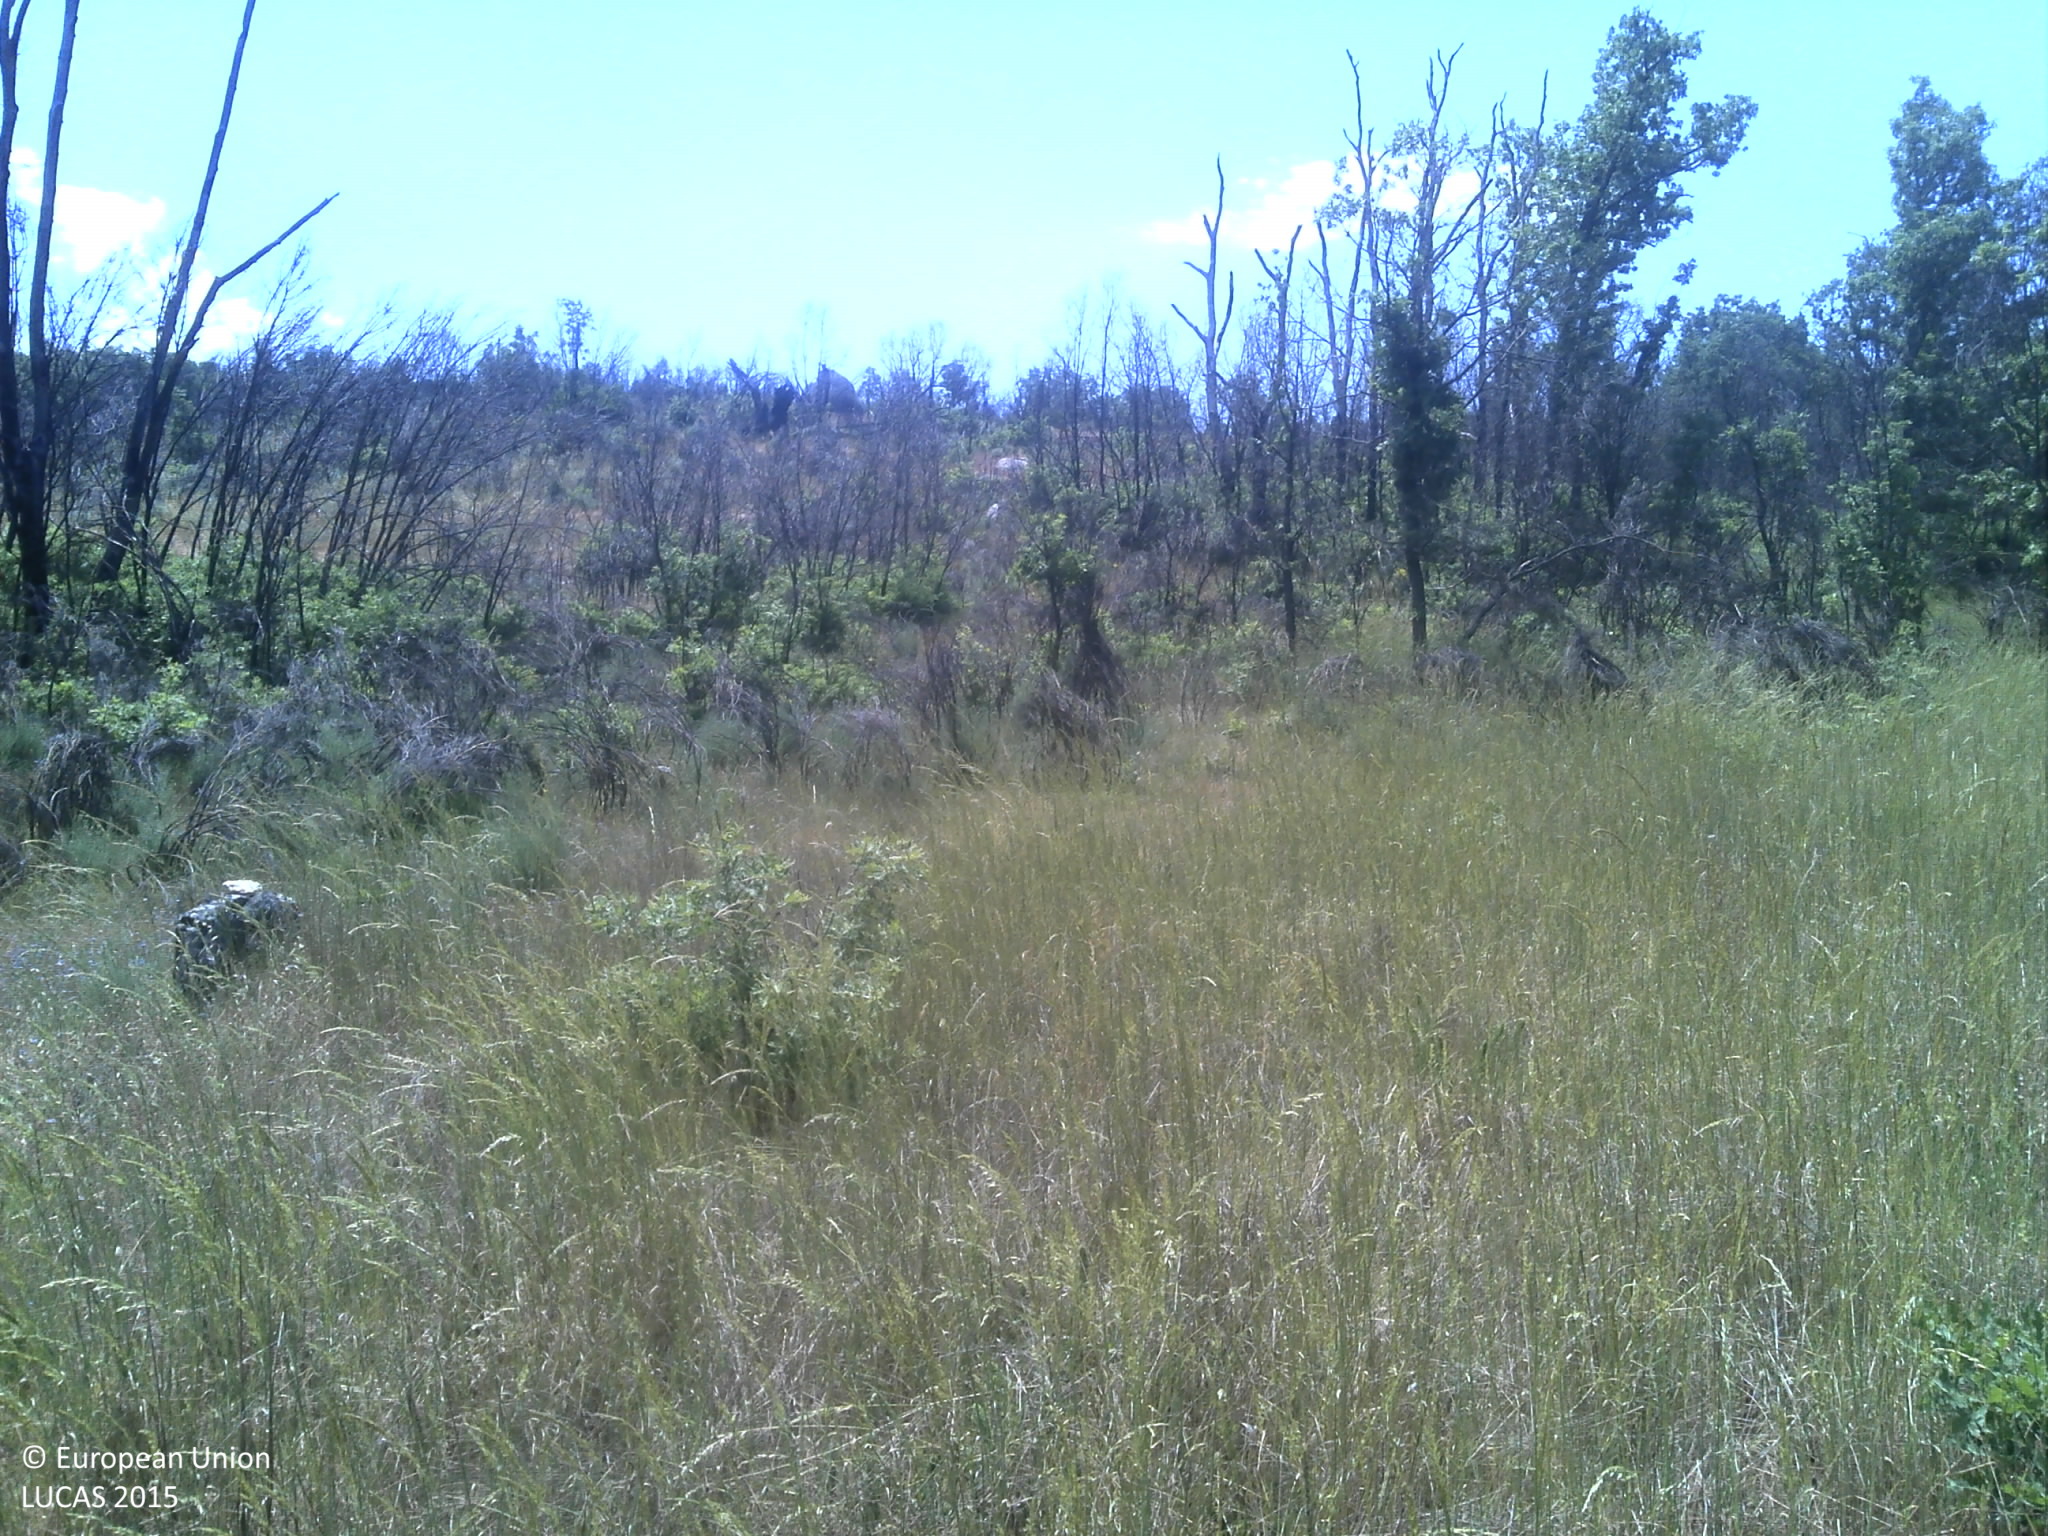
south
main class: Grassland
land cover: Grassland without tree/shrub cover
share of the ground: > 75 %
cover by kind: herbaceous plants 85 %, unconsolidated bare surface 15 %
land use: Agriculture (excluding fallow land and kitchen gardens)
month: June
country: PT
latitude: 40.4352
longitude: -7.1836
